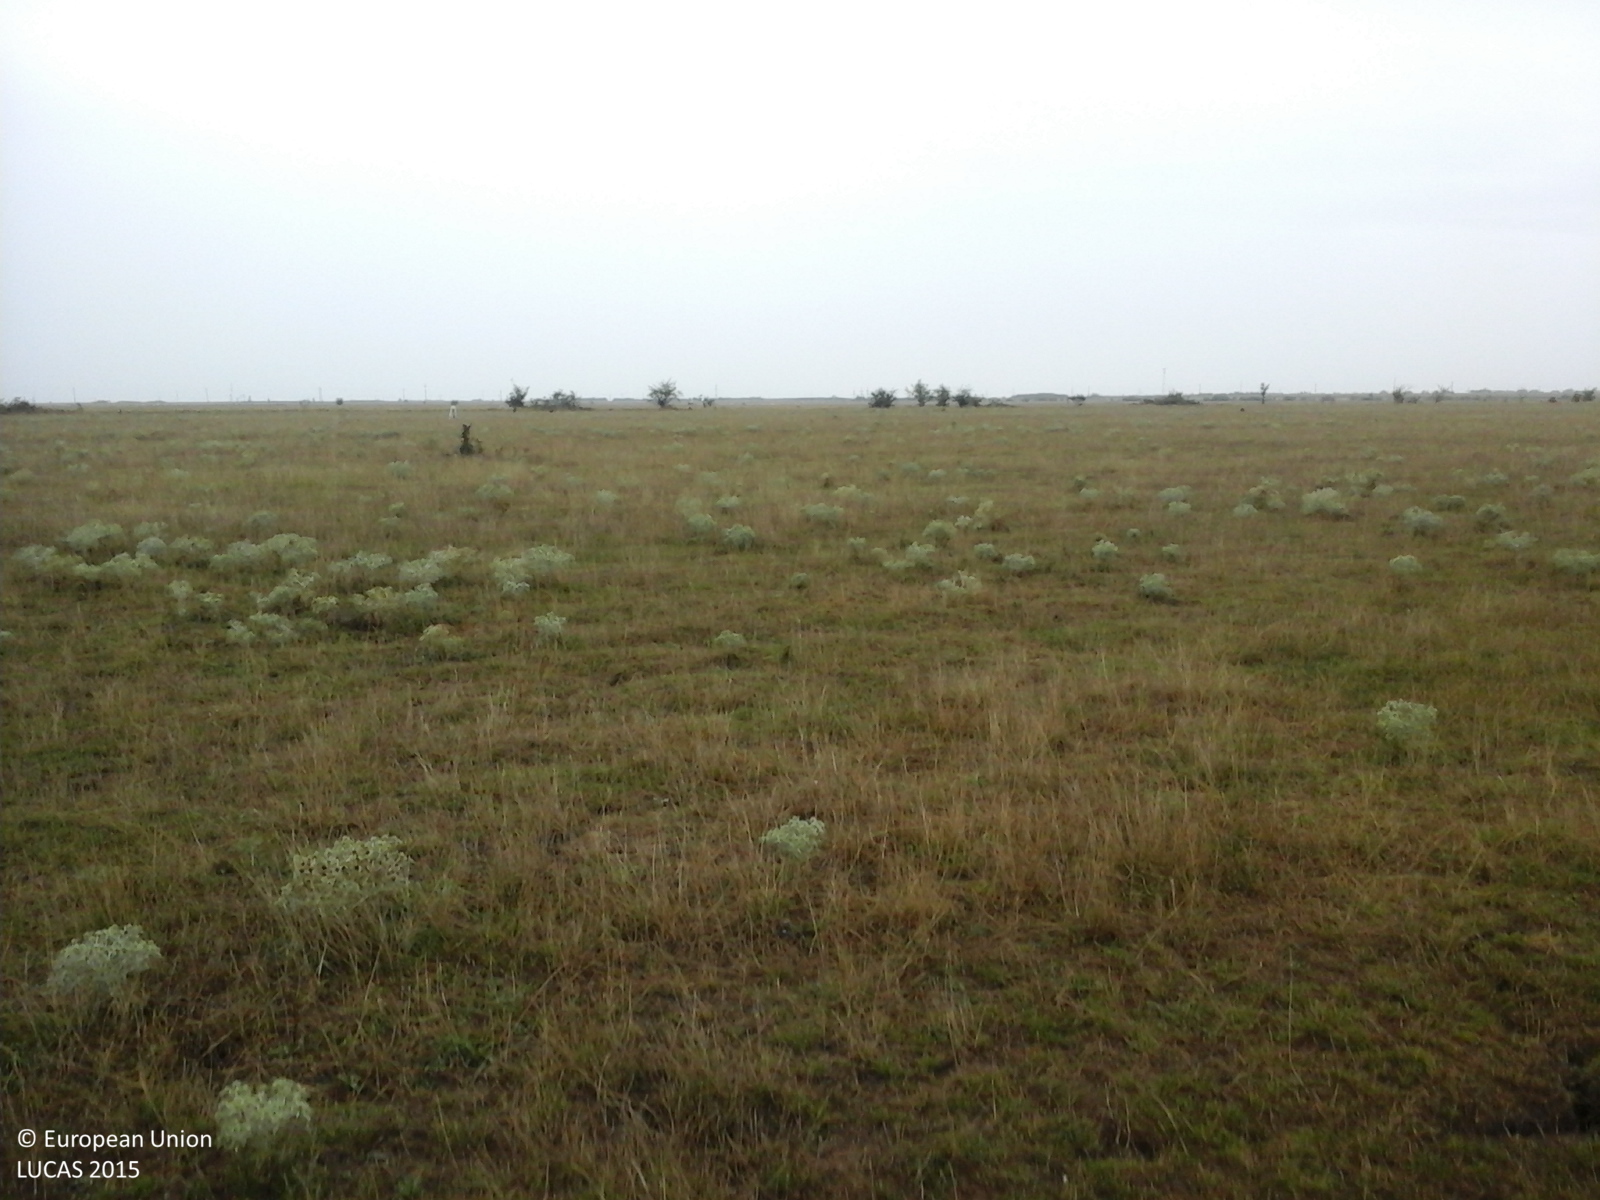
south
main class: Grassland
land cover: Spontaneously vegetated surfaces
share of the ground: > 75 %
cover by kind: herbaceous plants 100 %
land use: Fallow land
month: August
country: RO
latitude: 45.4639
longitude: 21.4266
